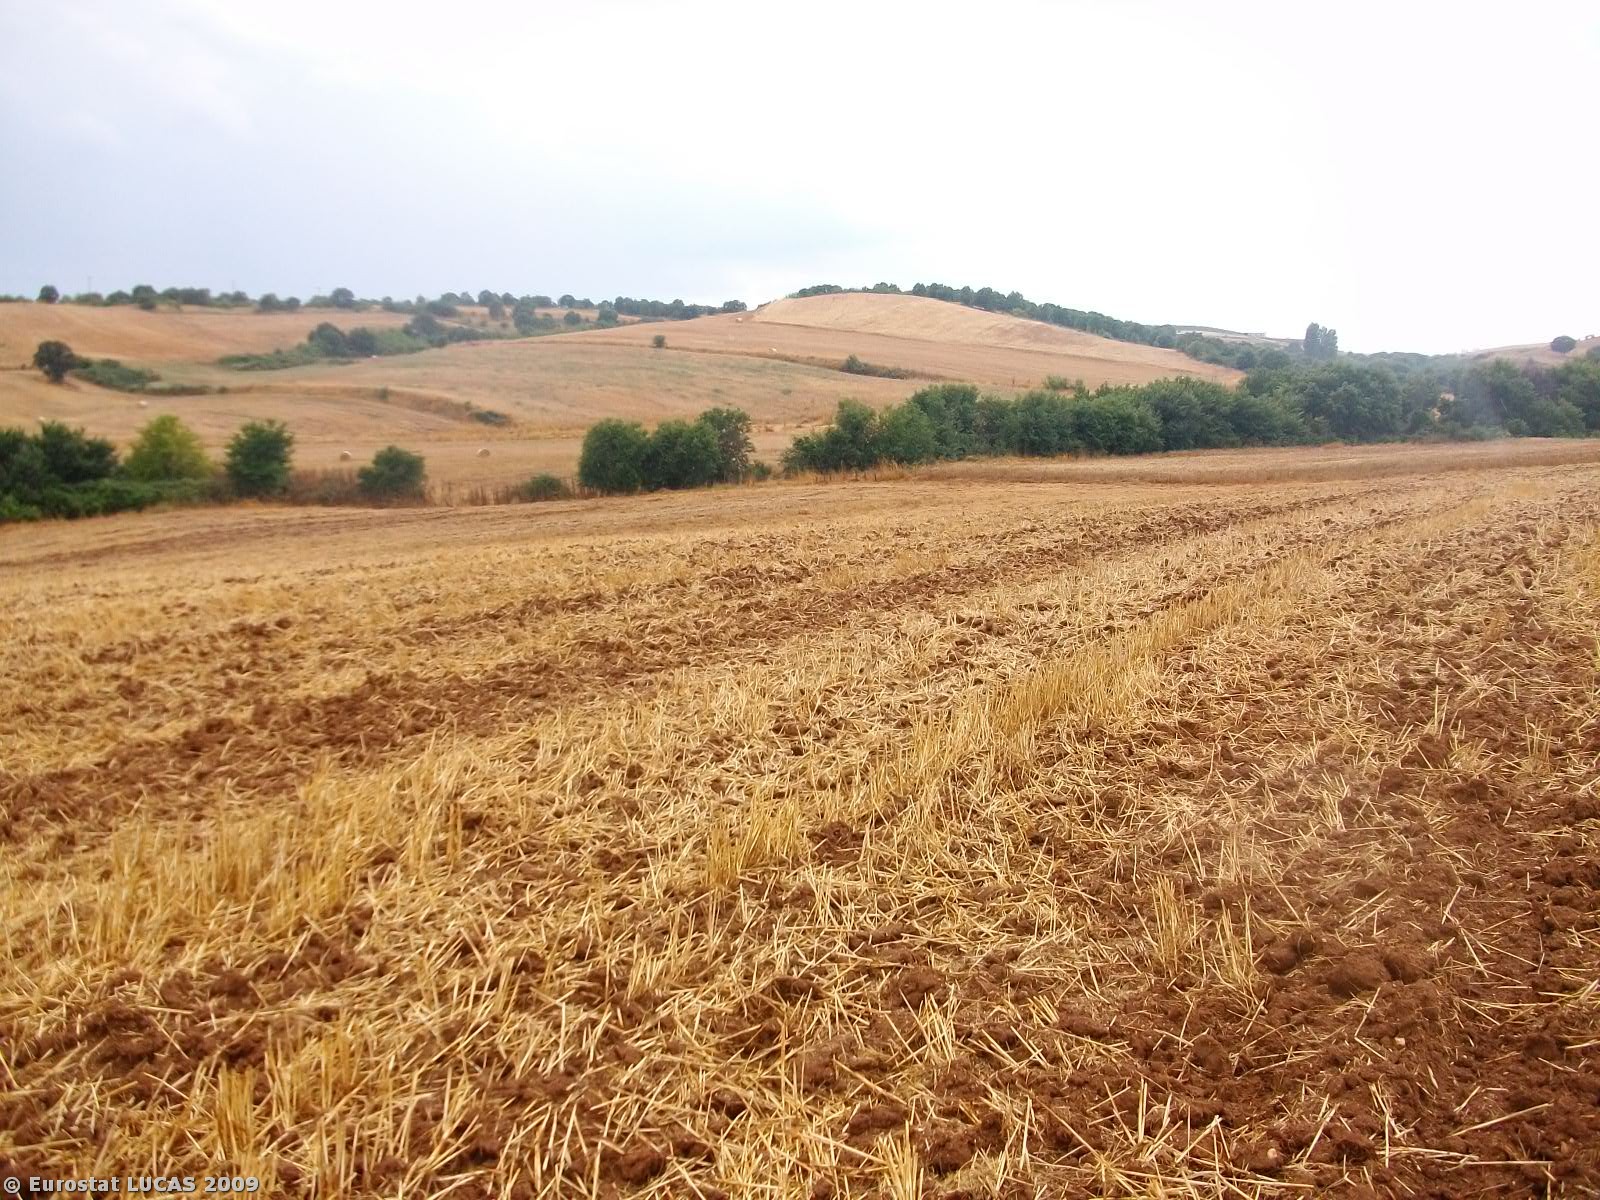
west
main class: Cropland
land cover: Barley
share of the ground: < 10 %
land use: Agriculture (excluding fallow land and kitchen gardens)
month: June
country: GR
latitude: 40.9808
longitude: 22.9300
